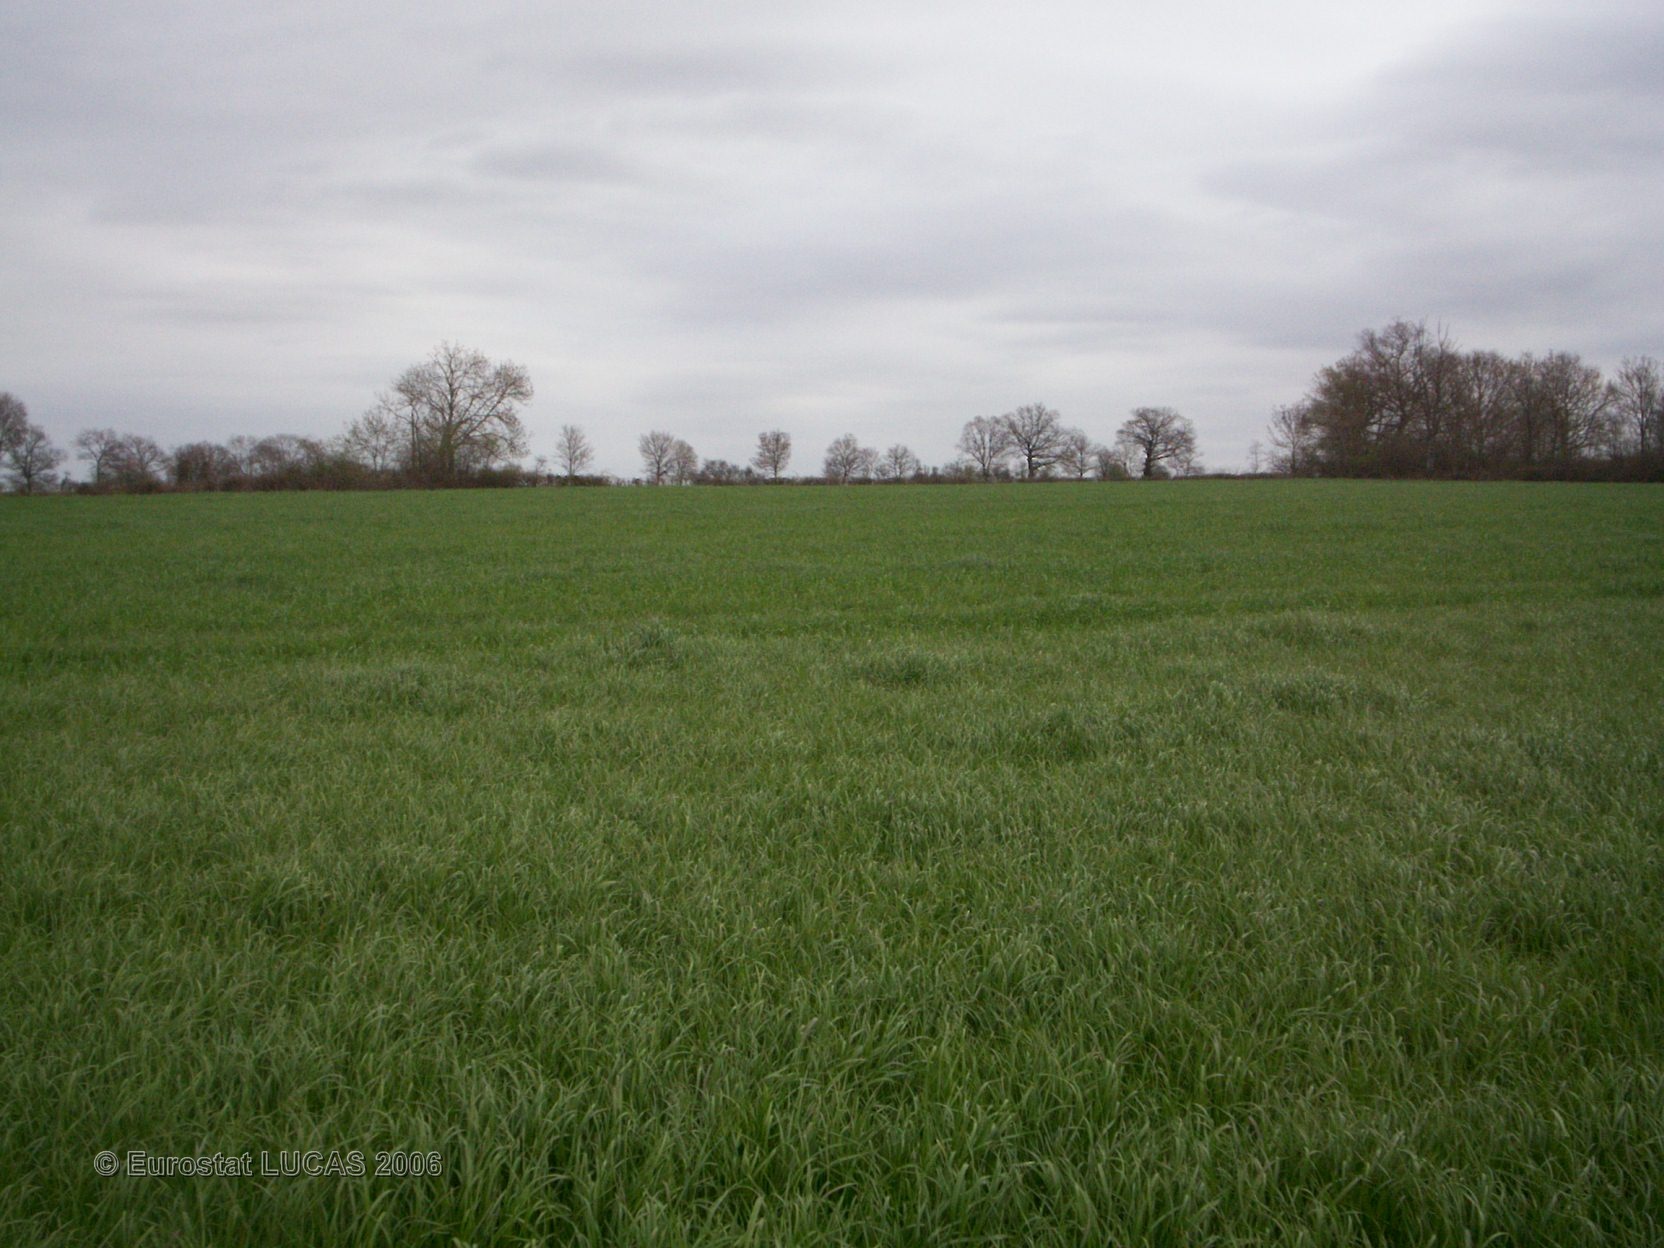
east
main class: Cropland
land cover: Barley
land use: Agriculture (excluding fallow land and kitchen gardens)
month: April
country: FR
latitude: 46.6677
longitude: 3.0564
